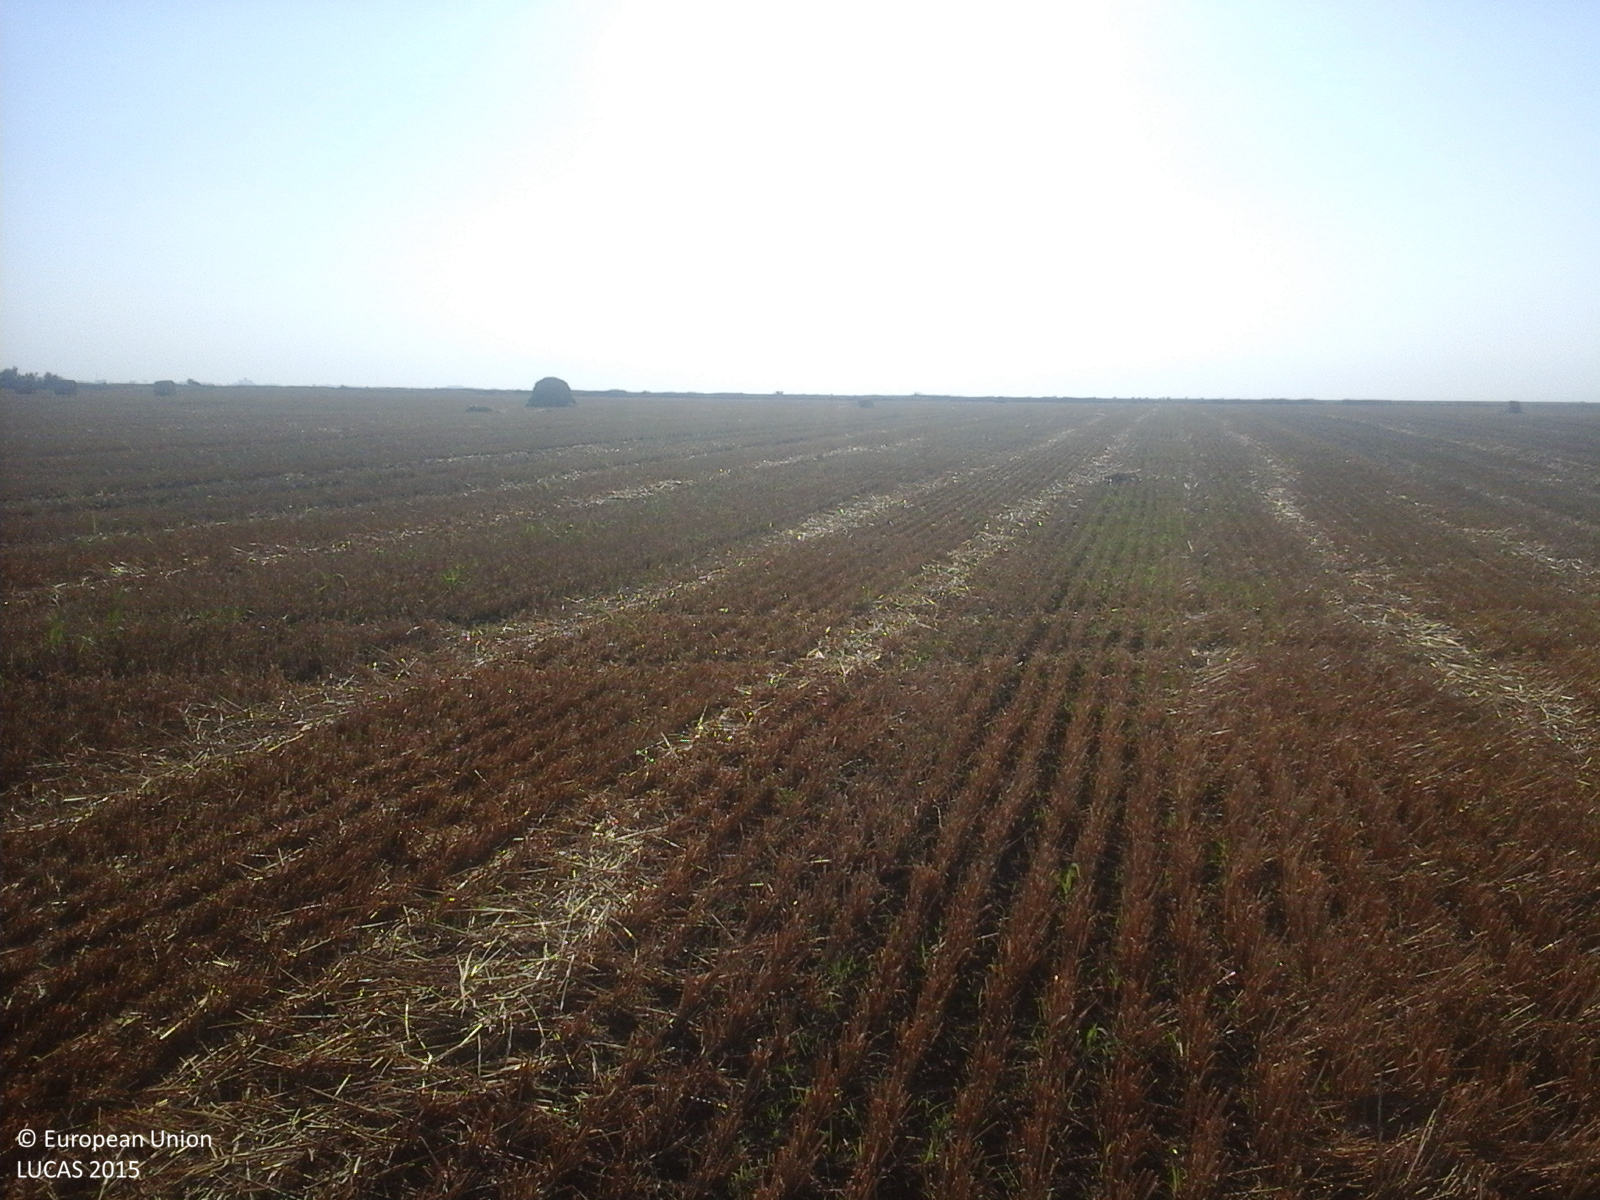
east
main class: Cropland
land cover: Durum wheat
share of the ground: 10 - 25 %
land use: Agriculture (excluding fallow land and kitchen gardens)
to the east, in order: Durum wheat
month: July
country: RO
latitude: 44.3850
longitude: 27.2431
